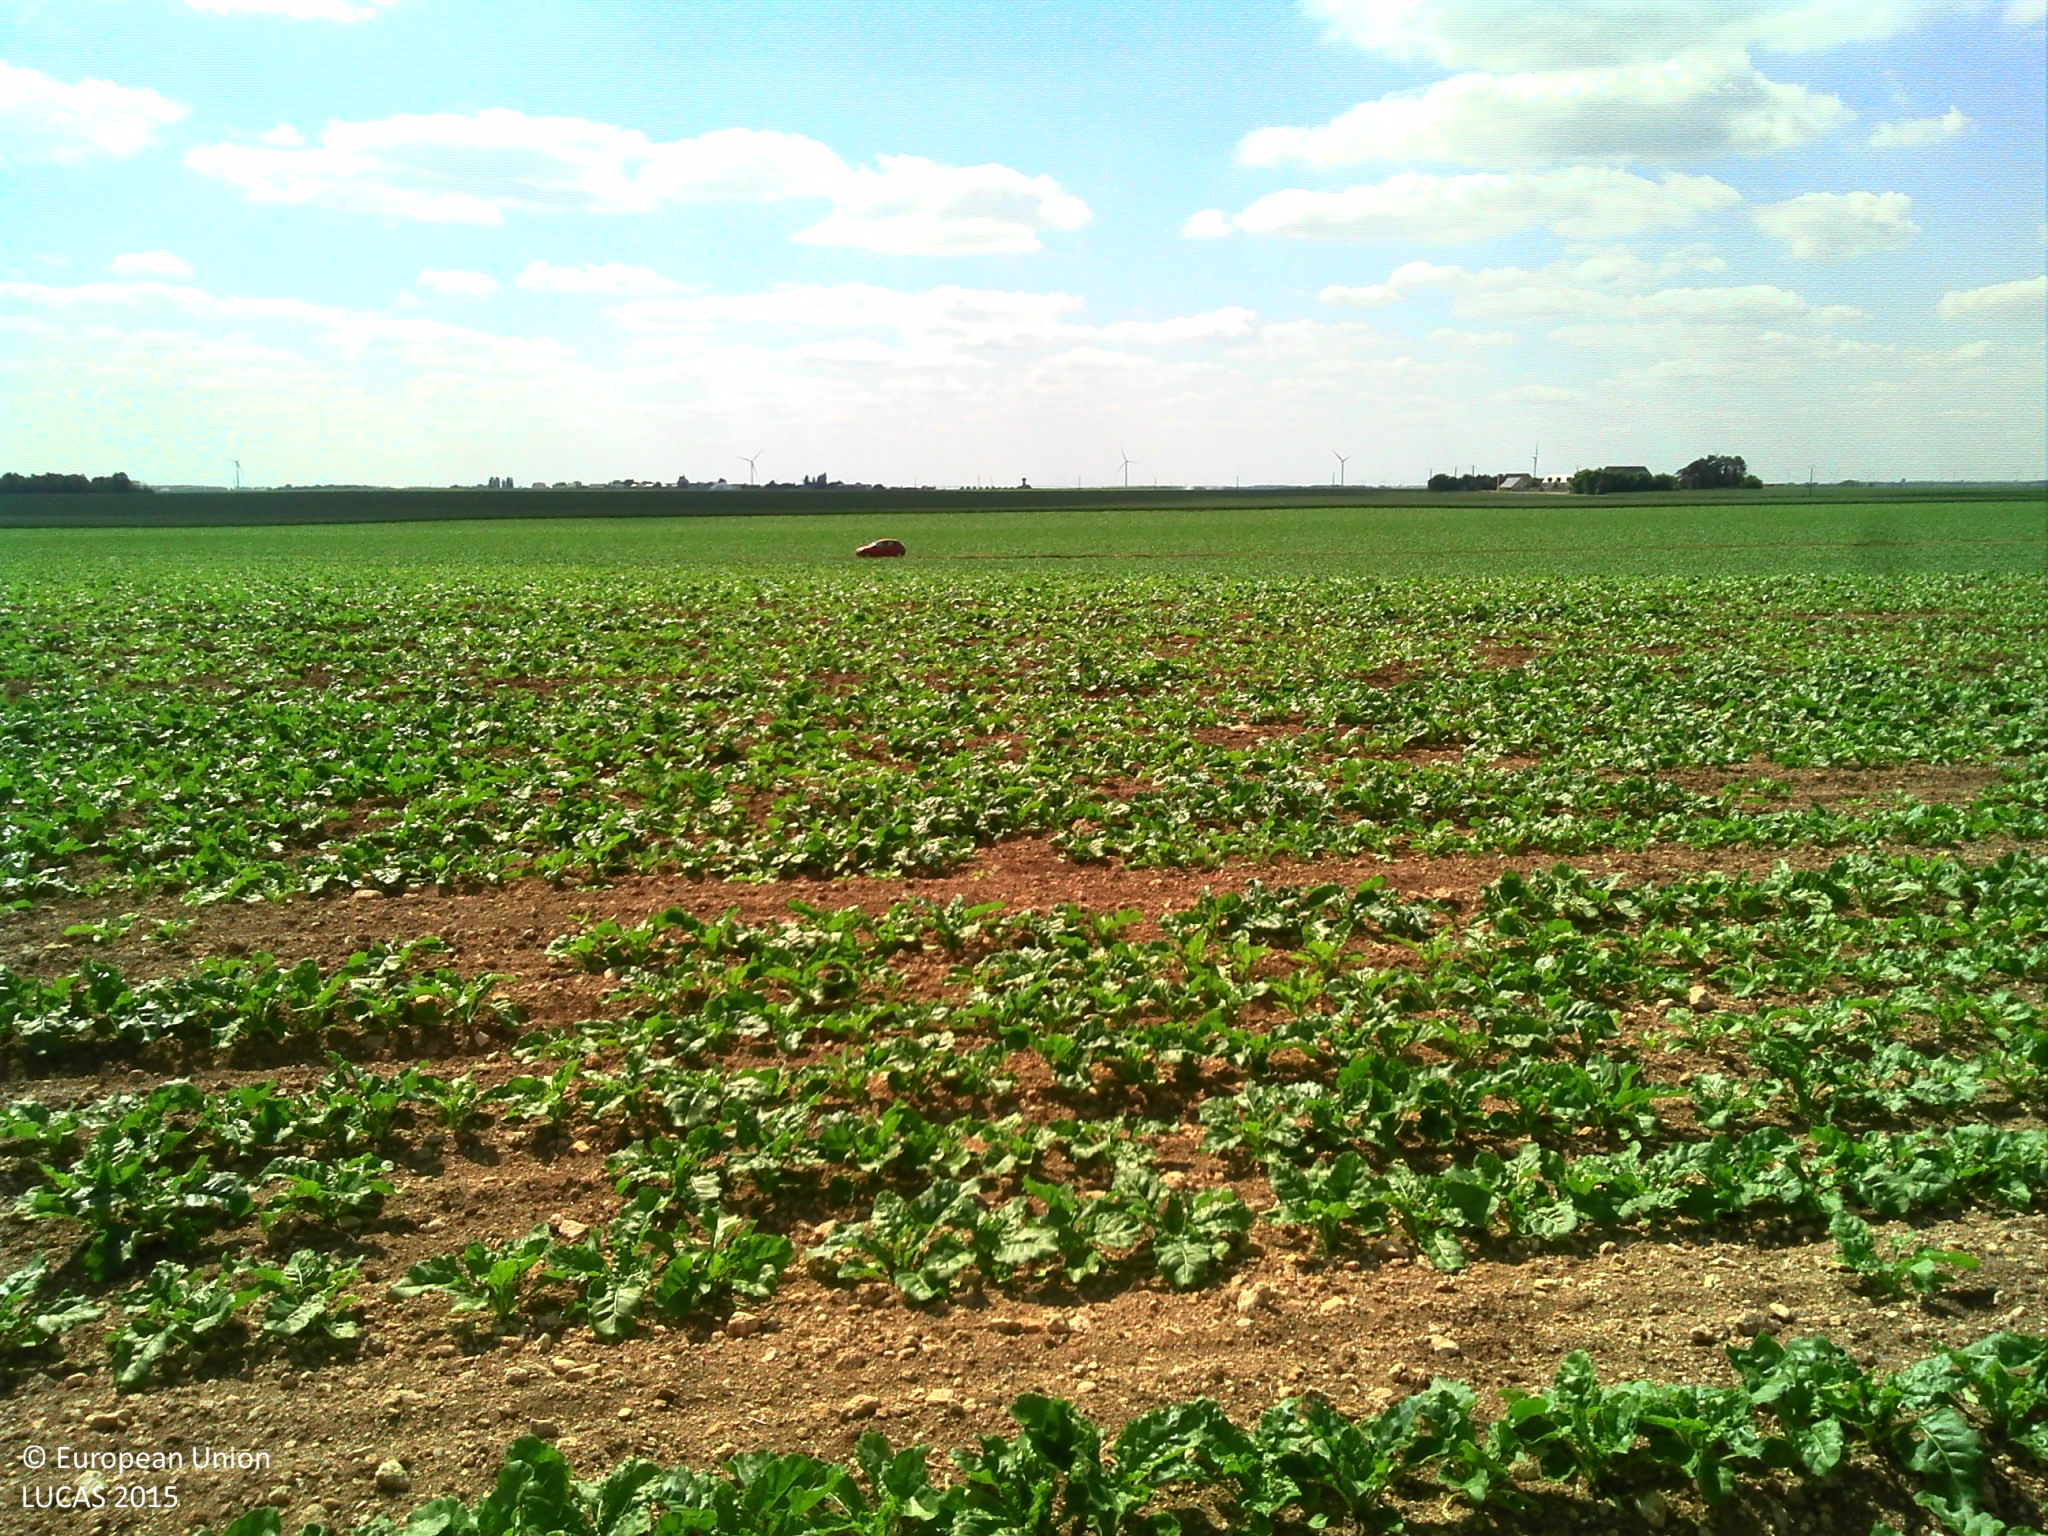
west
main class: Cropland
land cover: Sugar beet
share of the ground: 10 - 25 %
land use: Agriculture (excluding fallow land and kitchen gardens)
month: May
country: FR
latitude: 48.2699
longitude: 1.9162
